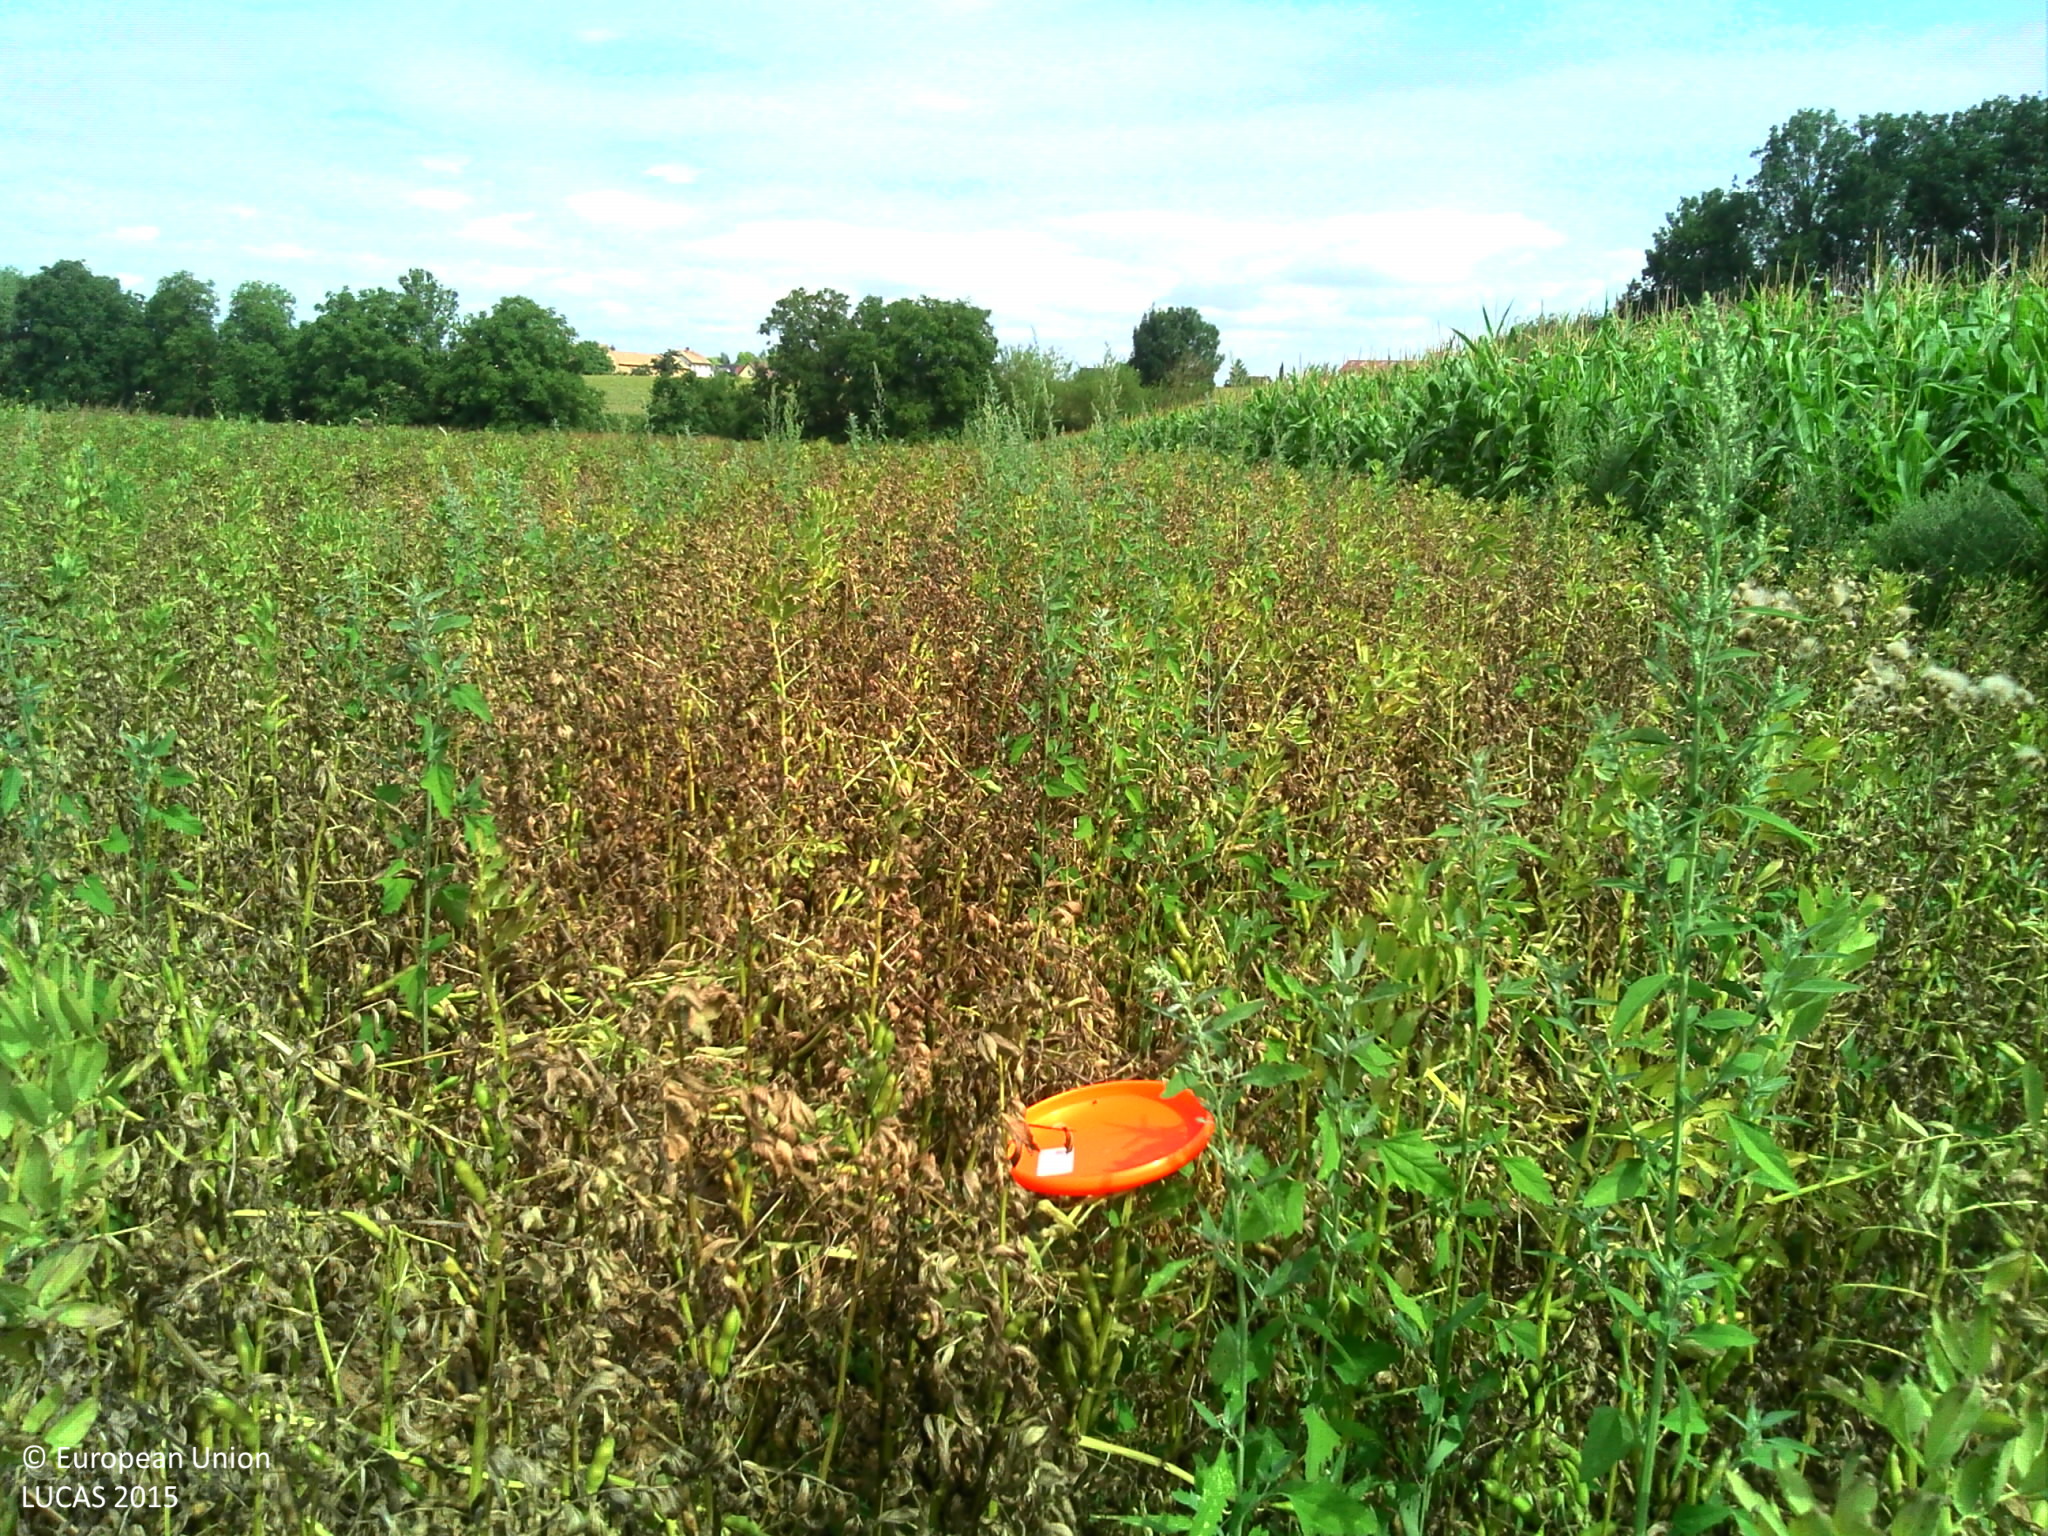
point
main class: Cropland
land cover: Soya
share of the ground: > 75 %
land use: Agriculture (excluding fallow land and kitchen gardens)
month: July
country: FR
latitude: 48.6115
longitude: 7.6001
